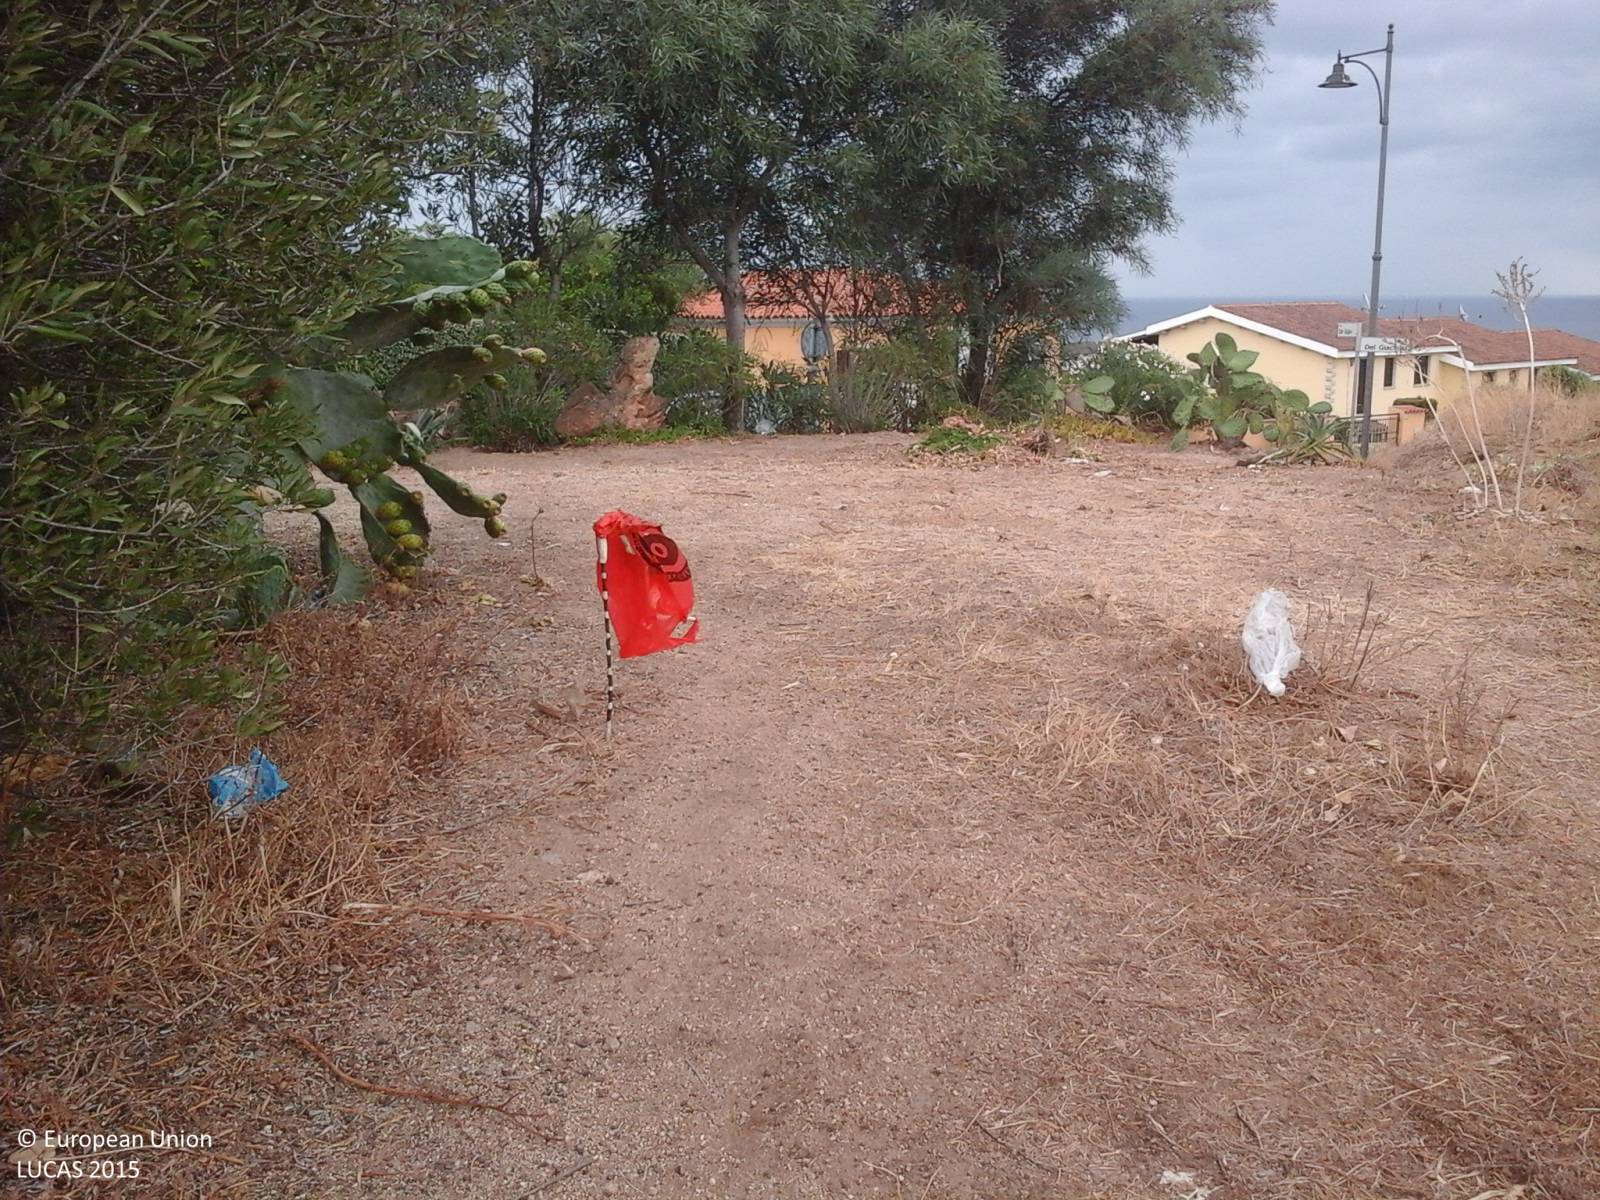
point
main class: Grassland
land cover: Grassland without tree/shrub cover
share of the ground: > 75 %
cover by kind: herbaceous plants 90 %, shrubs 5 %, unconsolidated bare surface 5 %
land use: Abandoned areas
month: August
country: IT
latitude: 40.9540
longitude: 9.5625
